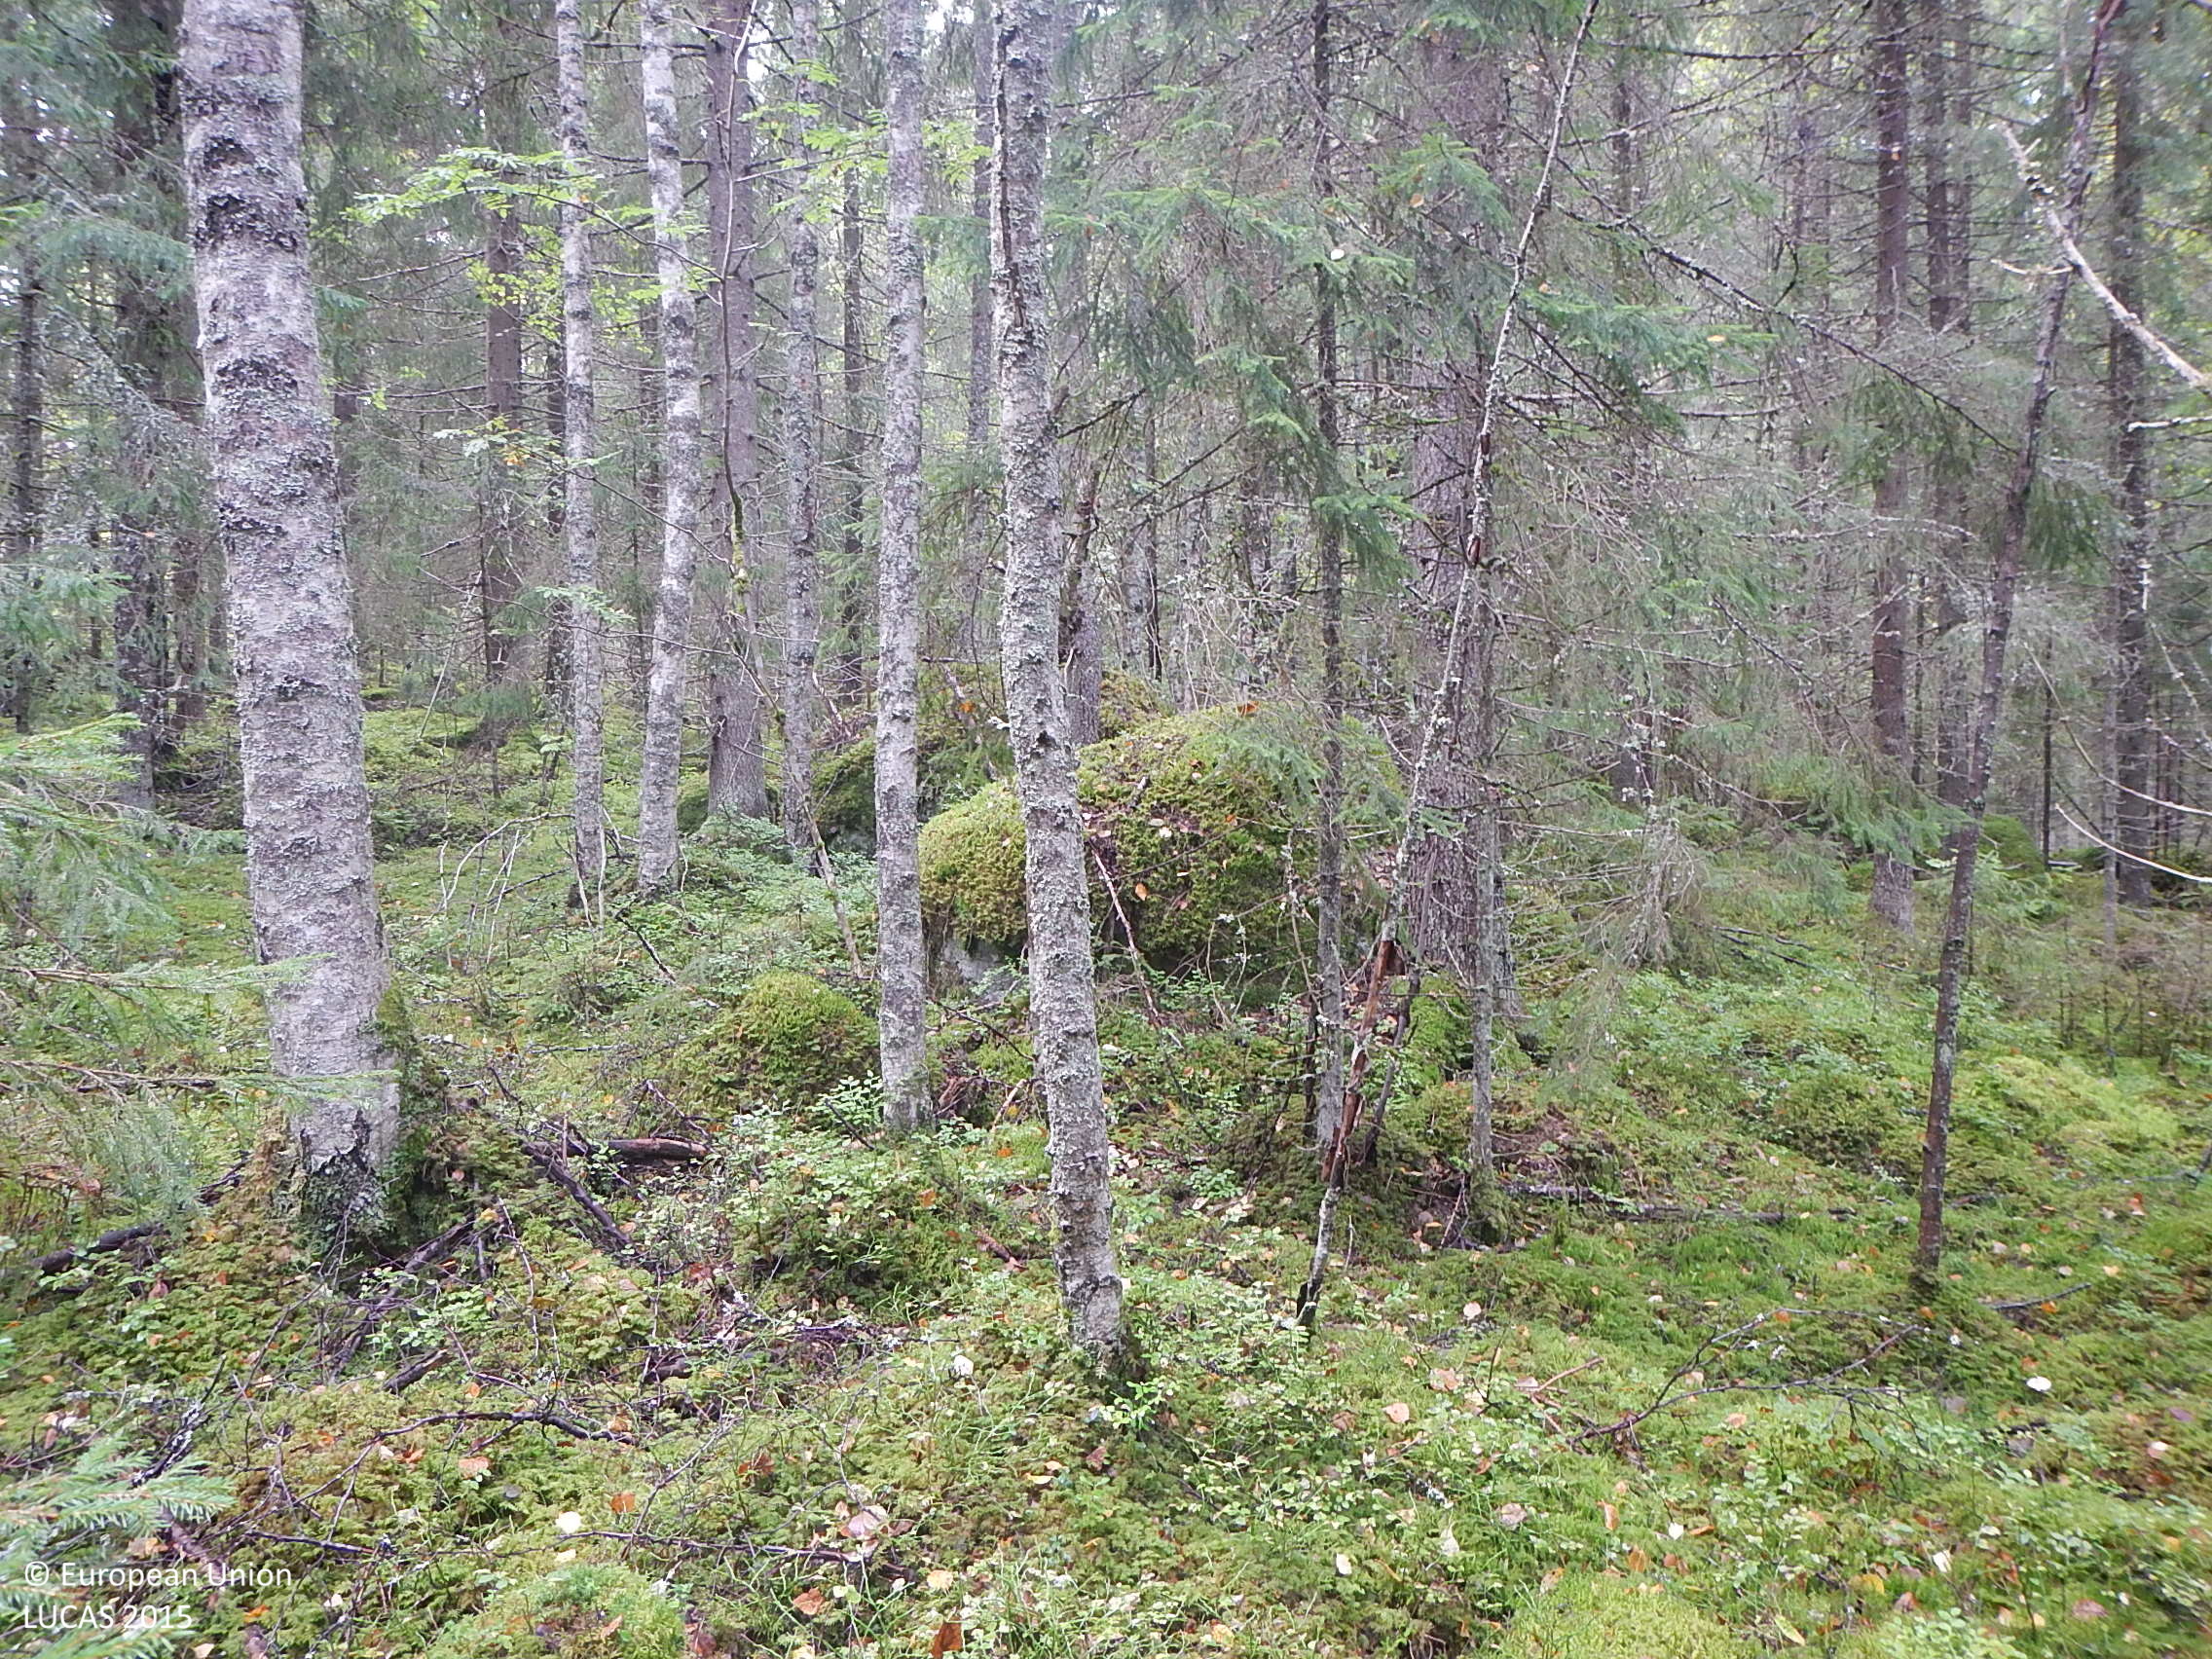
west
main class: Woodland
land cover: Spruce dominated mixed woodland
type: boreal forest
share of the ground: > 75 %
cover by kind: coniferous forest trees 50 %, broadleaved forest trees 25 %, lichens and mosses 20 %, shrubs 5 %
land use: Forestry
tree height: > 5 m
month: September
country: FI
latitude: 61.4886
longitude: 23.0870
